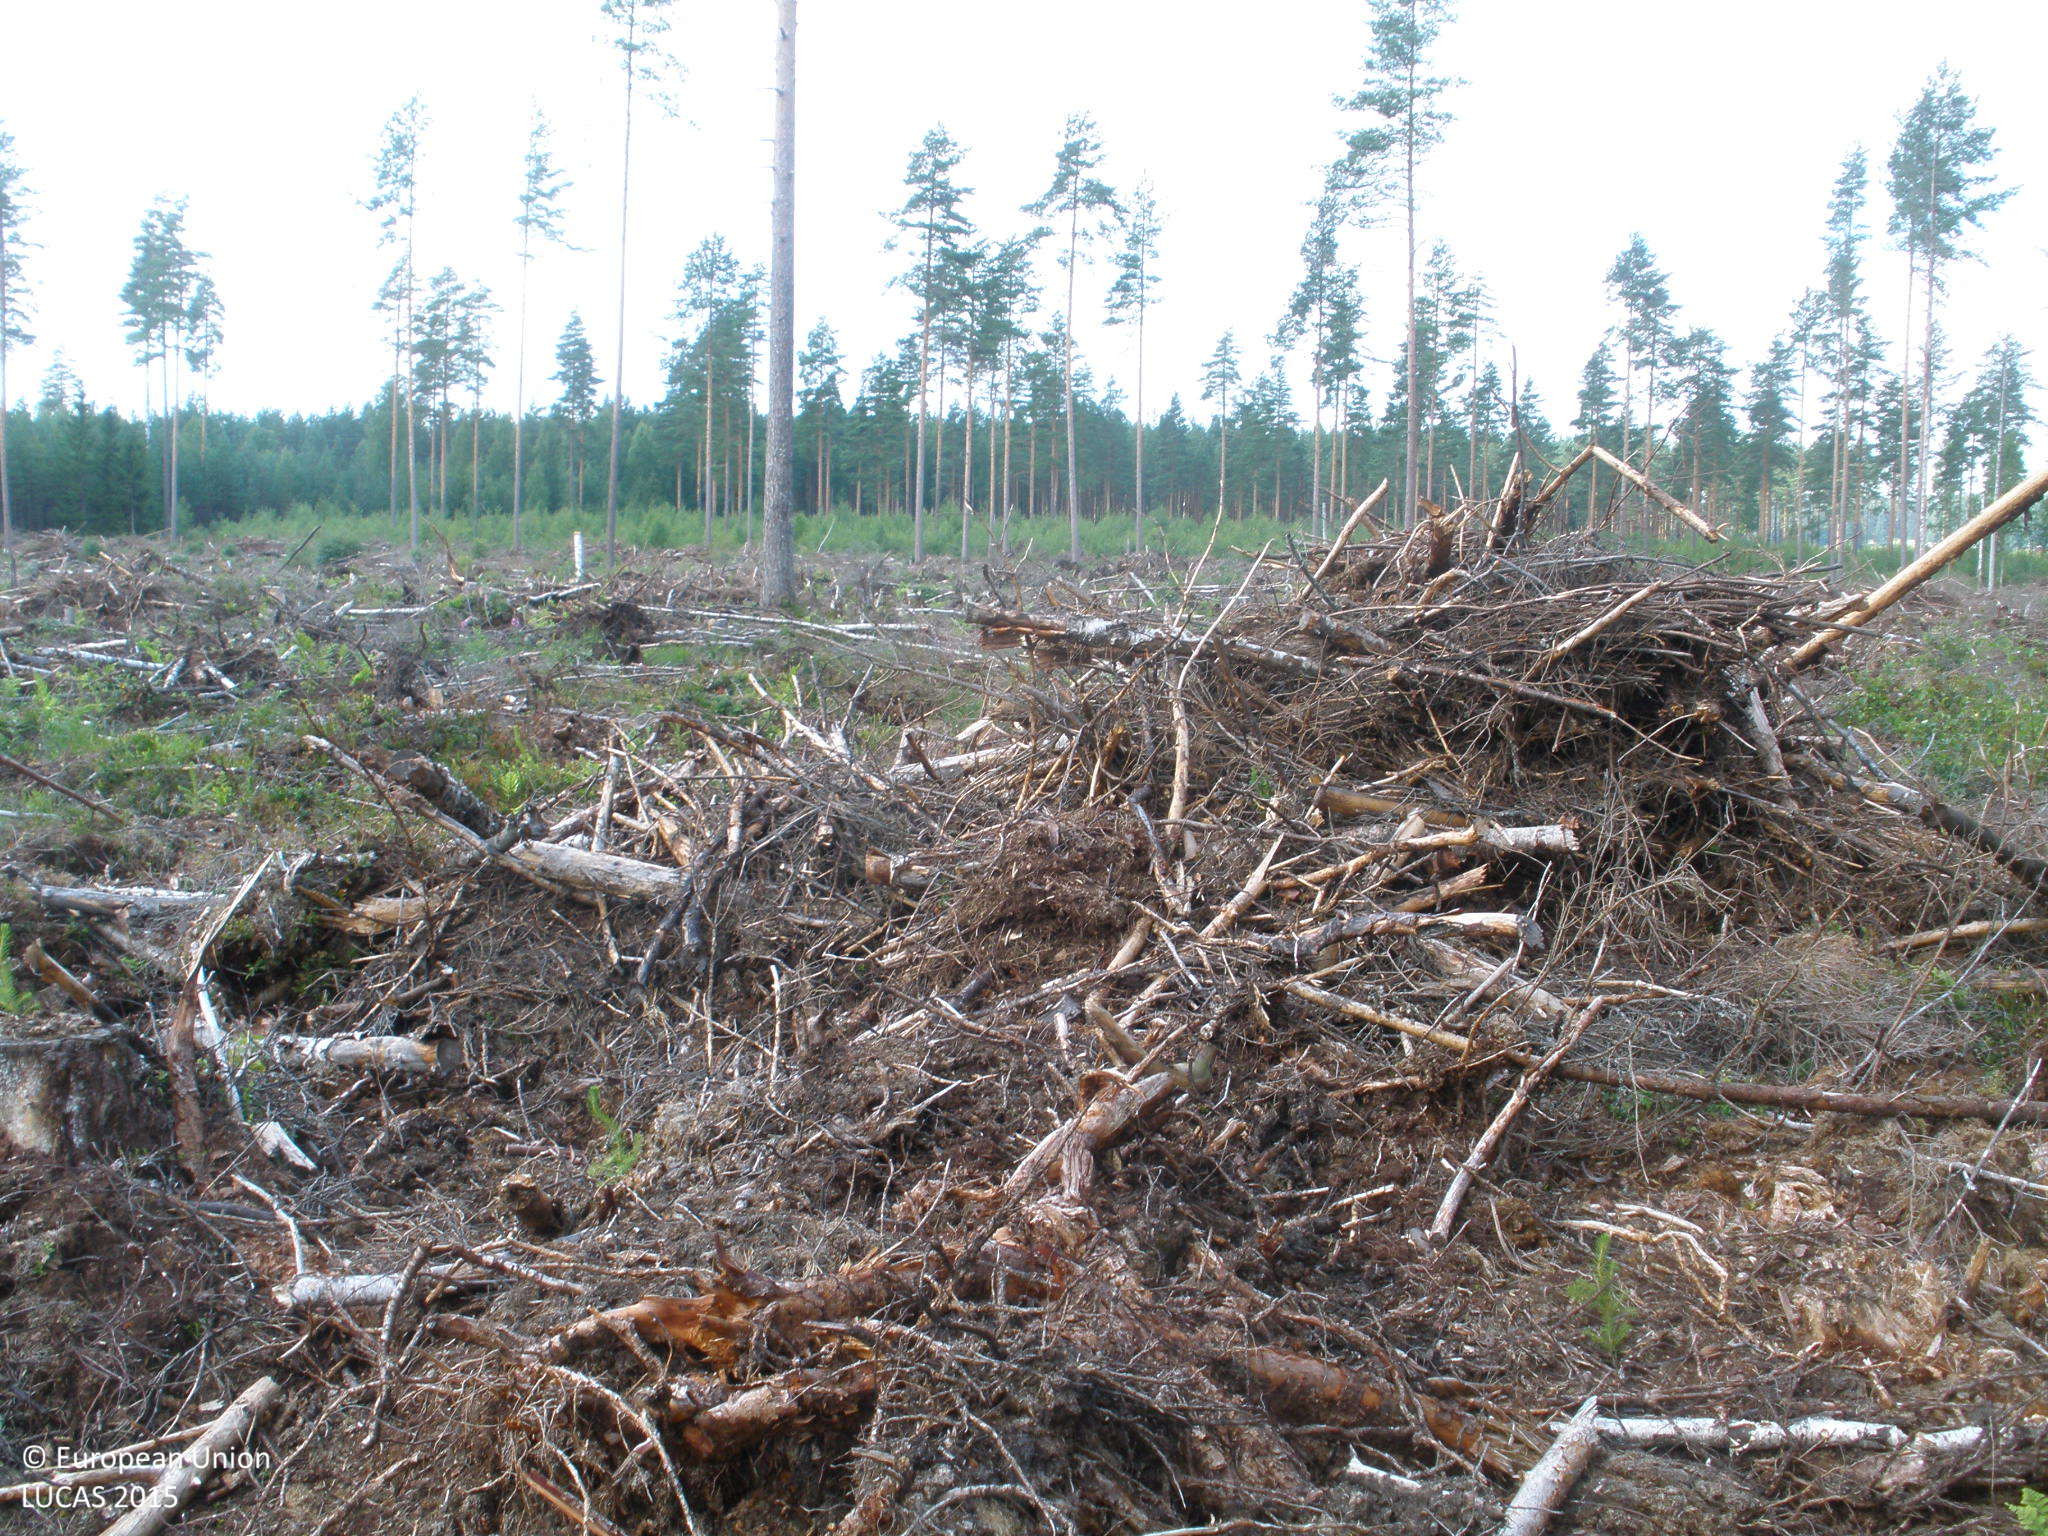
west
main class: Grassland
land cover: Grassland with sparse tree/shrub cover
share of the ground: 50 - 75 %
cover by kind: herbaceous plants 45 %, unconsolidated bare surface 25 %, consolidated bare surface 10 %, coniferous forest trees 5 %, shrubs 5 %
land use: Forestry
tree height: > 5 m
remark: Clear cut
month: August
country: FI
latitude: 60.6596
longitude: 24.2795
